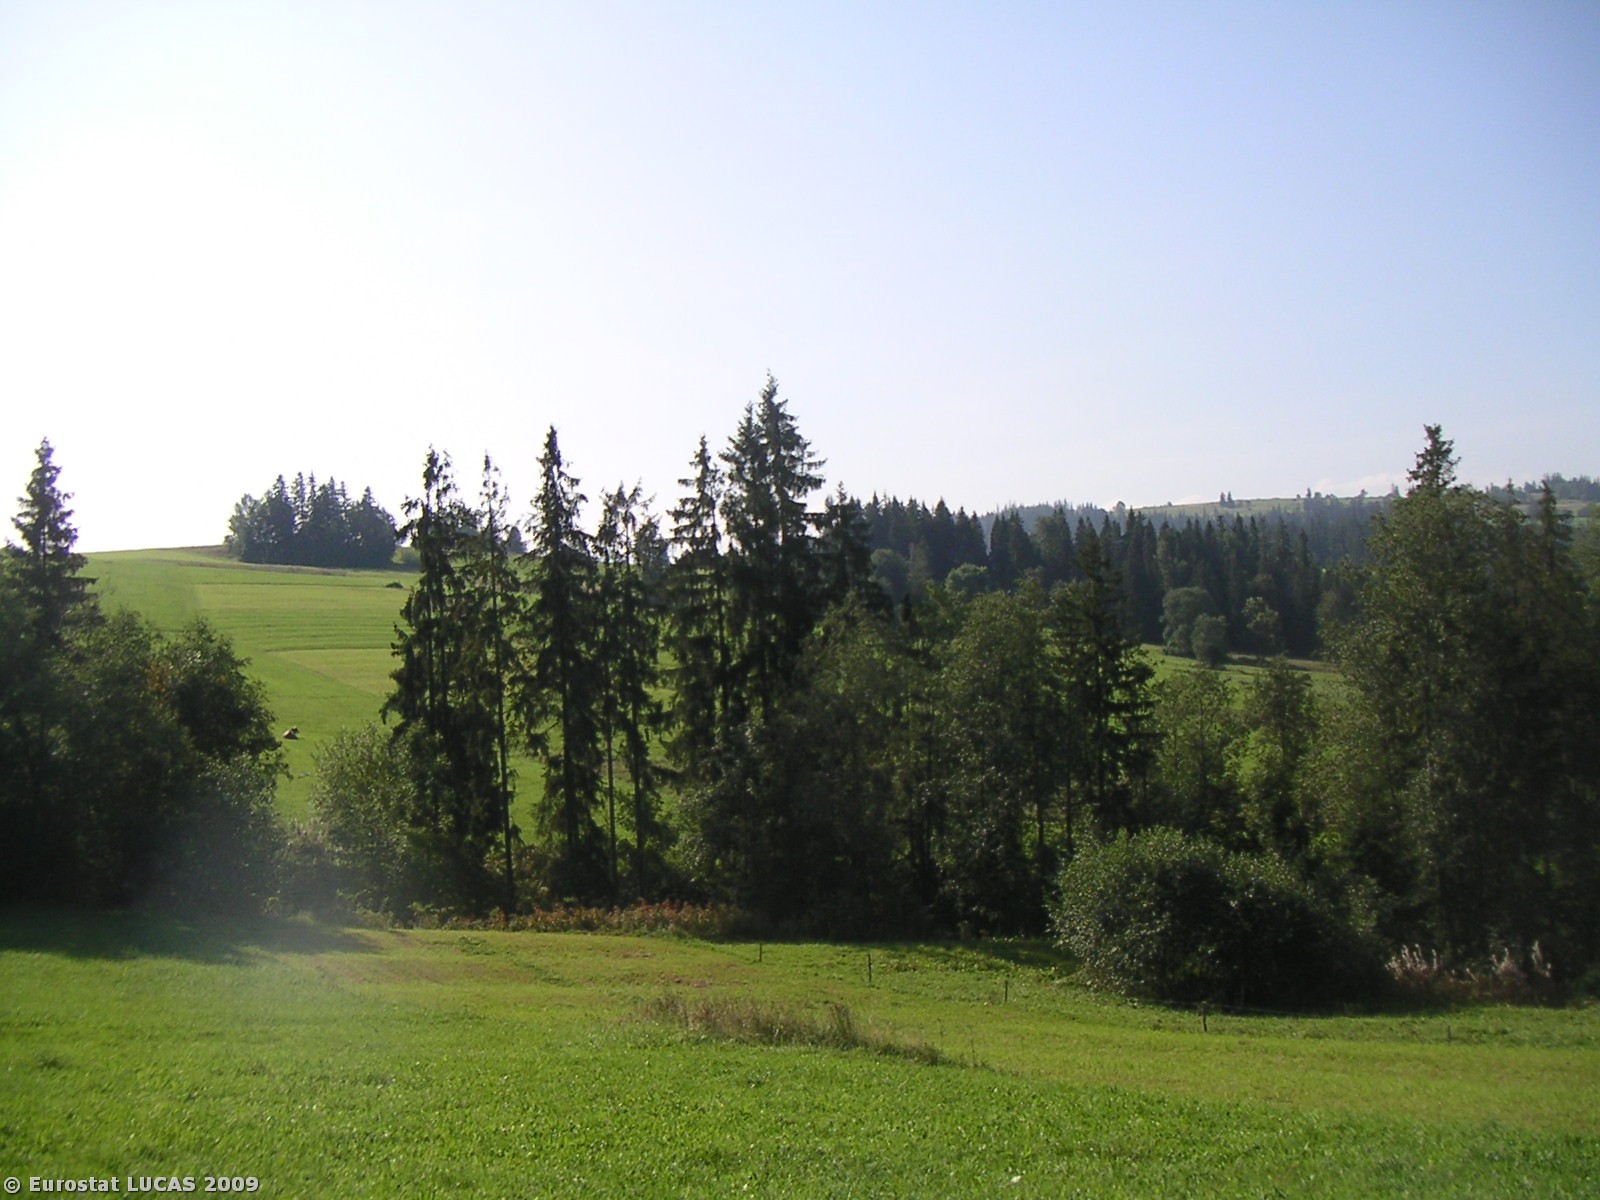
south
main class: Grassland
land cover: Grassland without tree/shrub cover
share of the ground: > 75 %
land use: Agriculture (excluding fallow land and kitchen gardens)
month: September
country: PL
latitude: 49.4102
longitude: 20.0798
